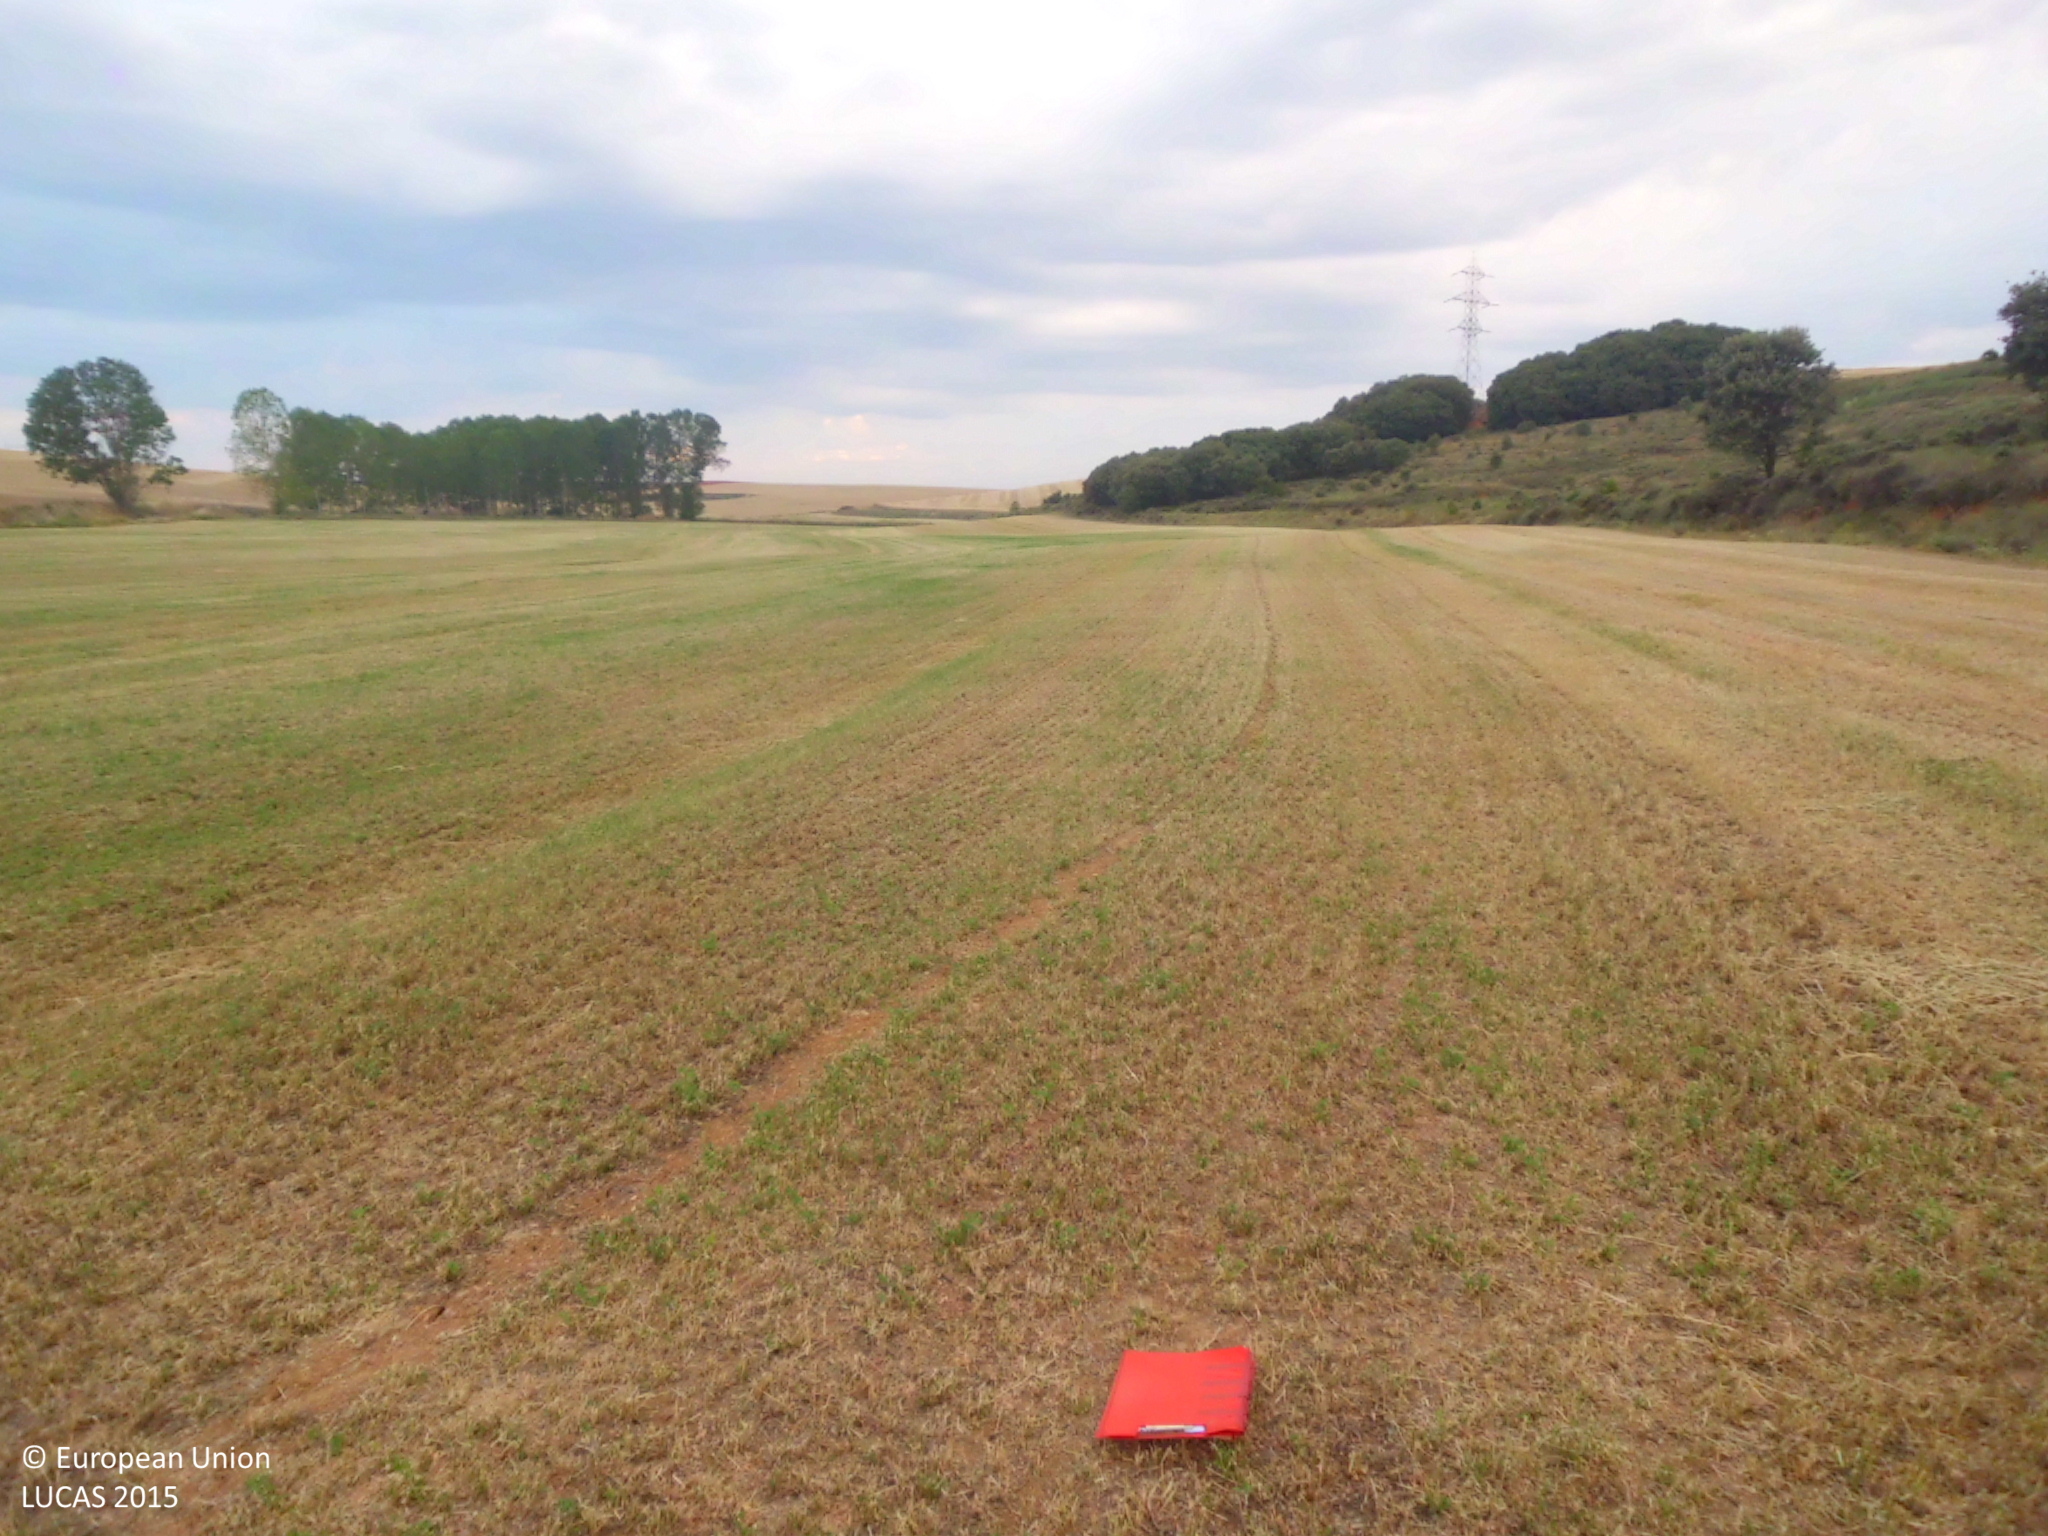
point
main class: Cropland
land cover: Lucerne
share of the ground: < 10 %
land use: Agriculture (excluding fallow land and kitchen gardens)
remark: Harvested field
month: July
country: ES
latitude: 42.6224
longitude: -4.4259
